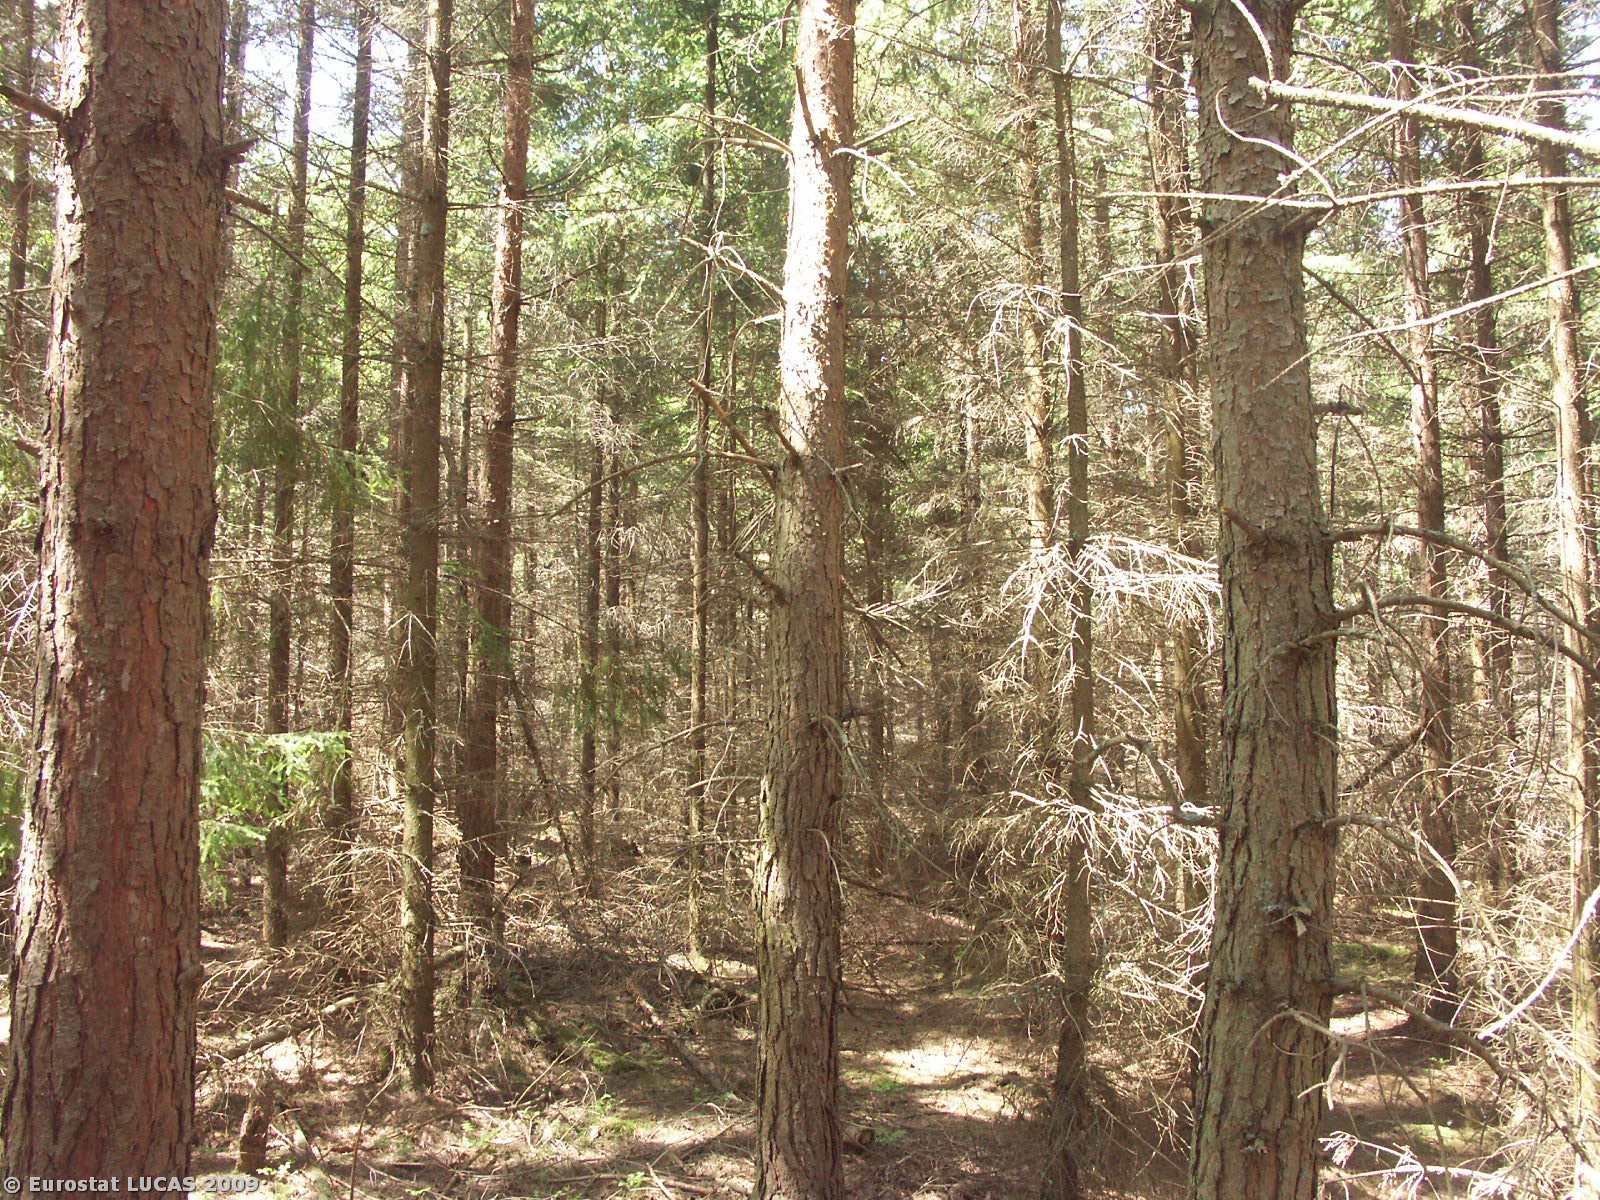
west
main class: Woodland
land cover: Coniferous woodland
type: hemiboreal forest and nemoral coniferous forest and mixed broadleaved-coniferous forest
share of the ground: > 75 %
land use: Forestry
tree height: > 5 m
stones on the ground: < 10 %
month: May
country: CZ
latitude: 48.8598
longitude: 14.7586
